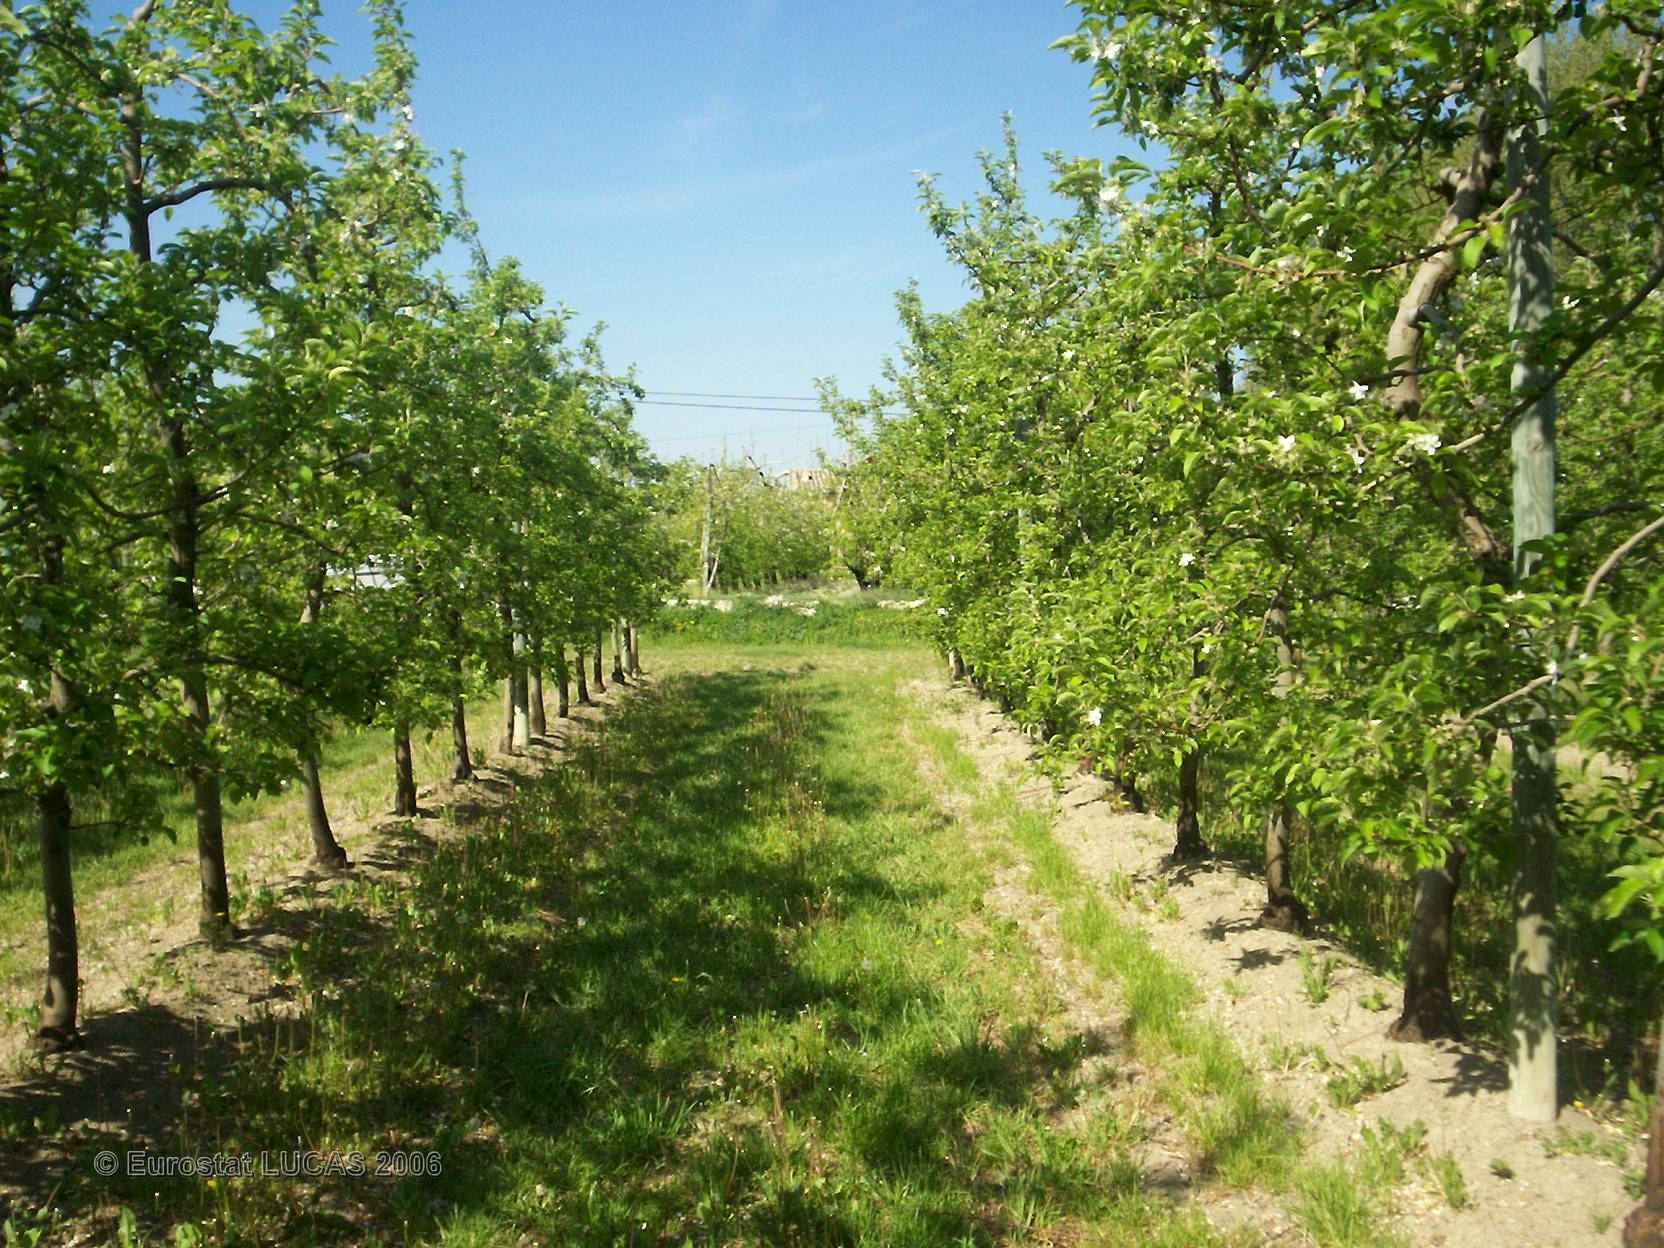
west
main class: Cropland
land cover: Apple fruit
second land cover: Grassland with sparse tree/shrub cover
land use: Agriculture (excluding fallow land and kitchen gardens)
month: April
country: FR
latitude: 43.8864
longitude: 4.9926
